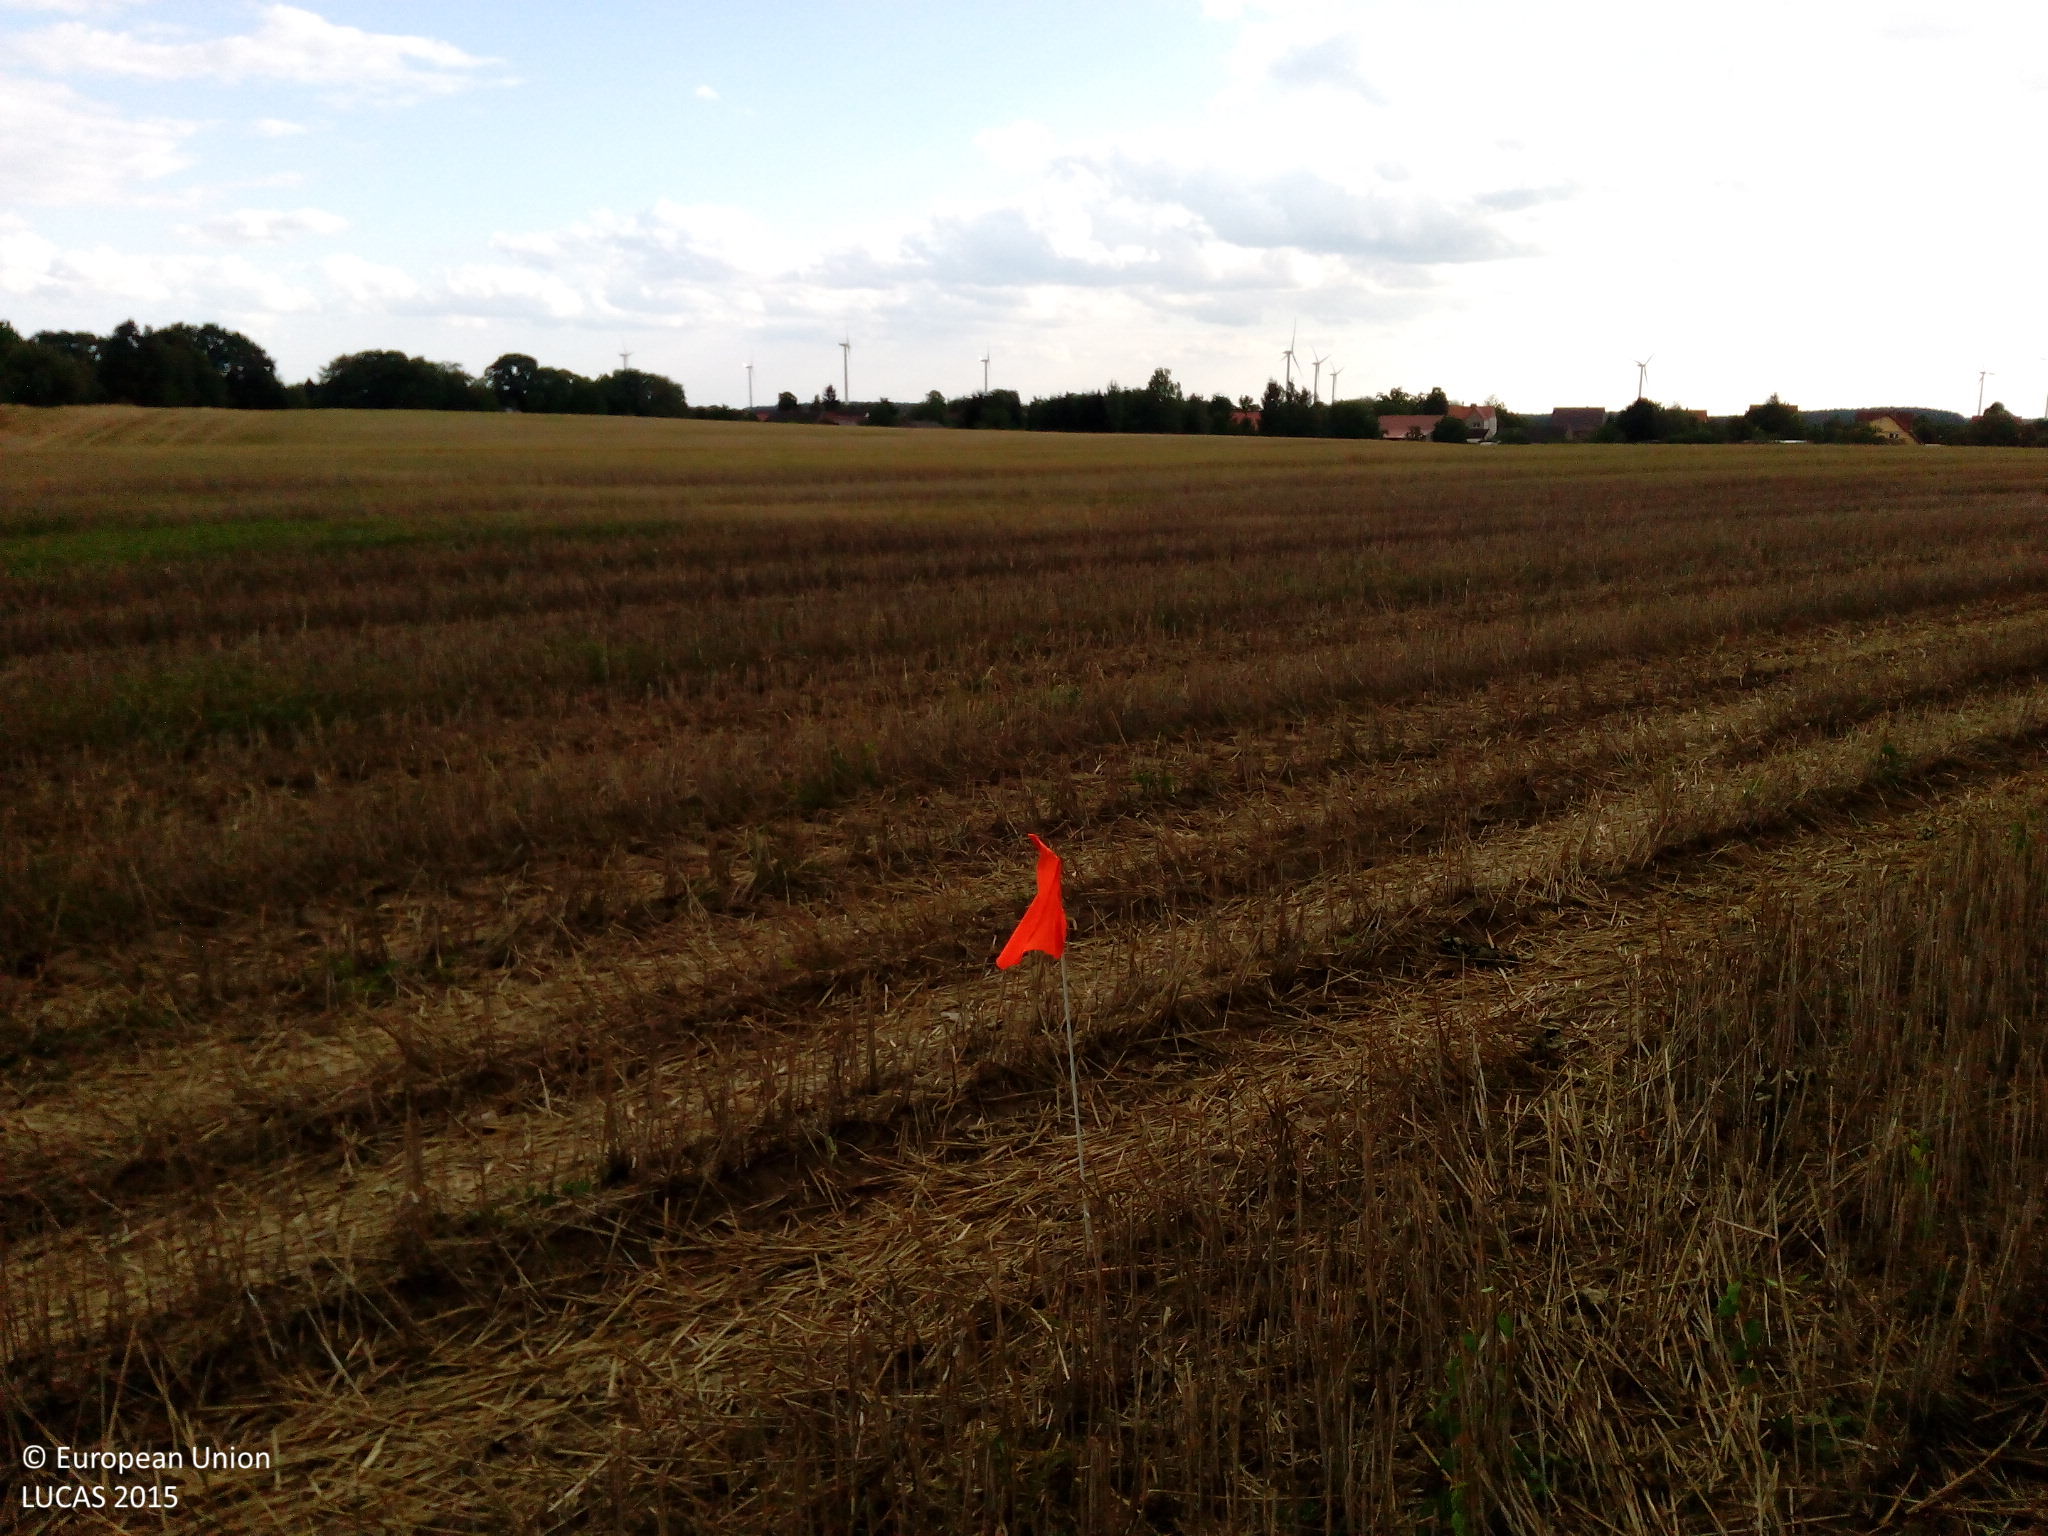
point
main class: Cropland
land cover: Rye
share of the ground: > 75 %
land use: Agriculture (excluding fallow land and kitchen gardens)
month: July
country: DE
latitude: 52.2173
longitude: 14.0847
